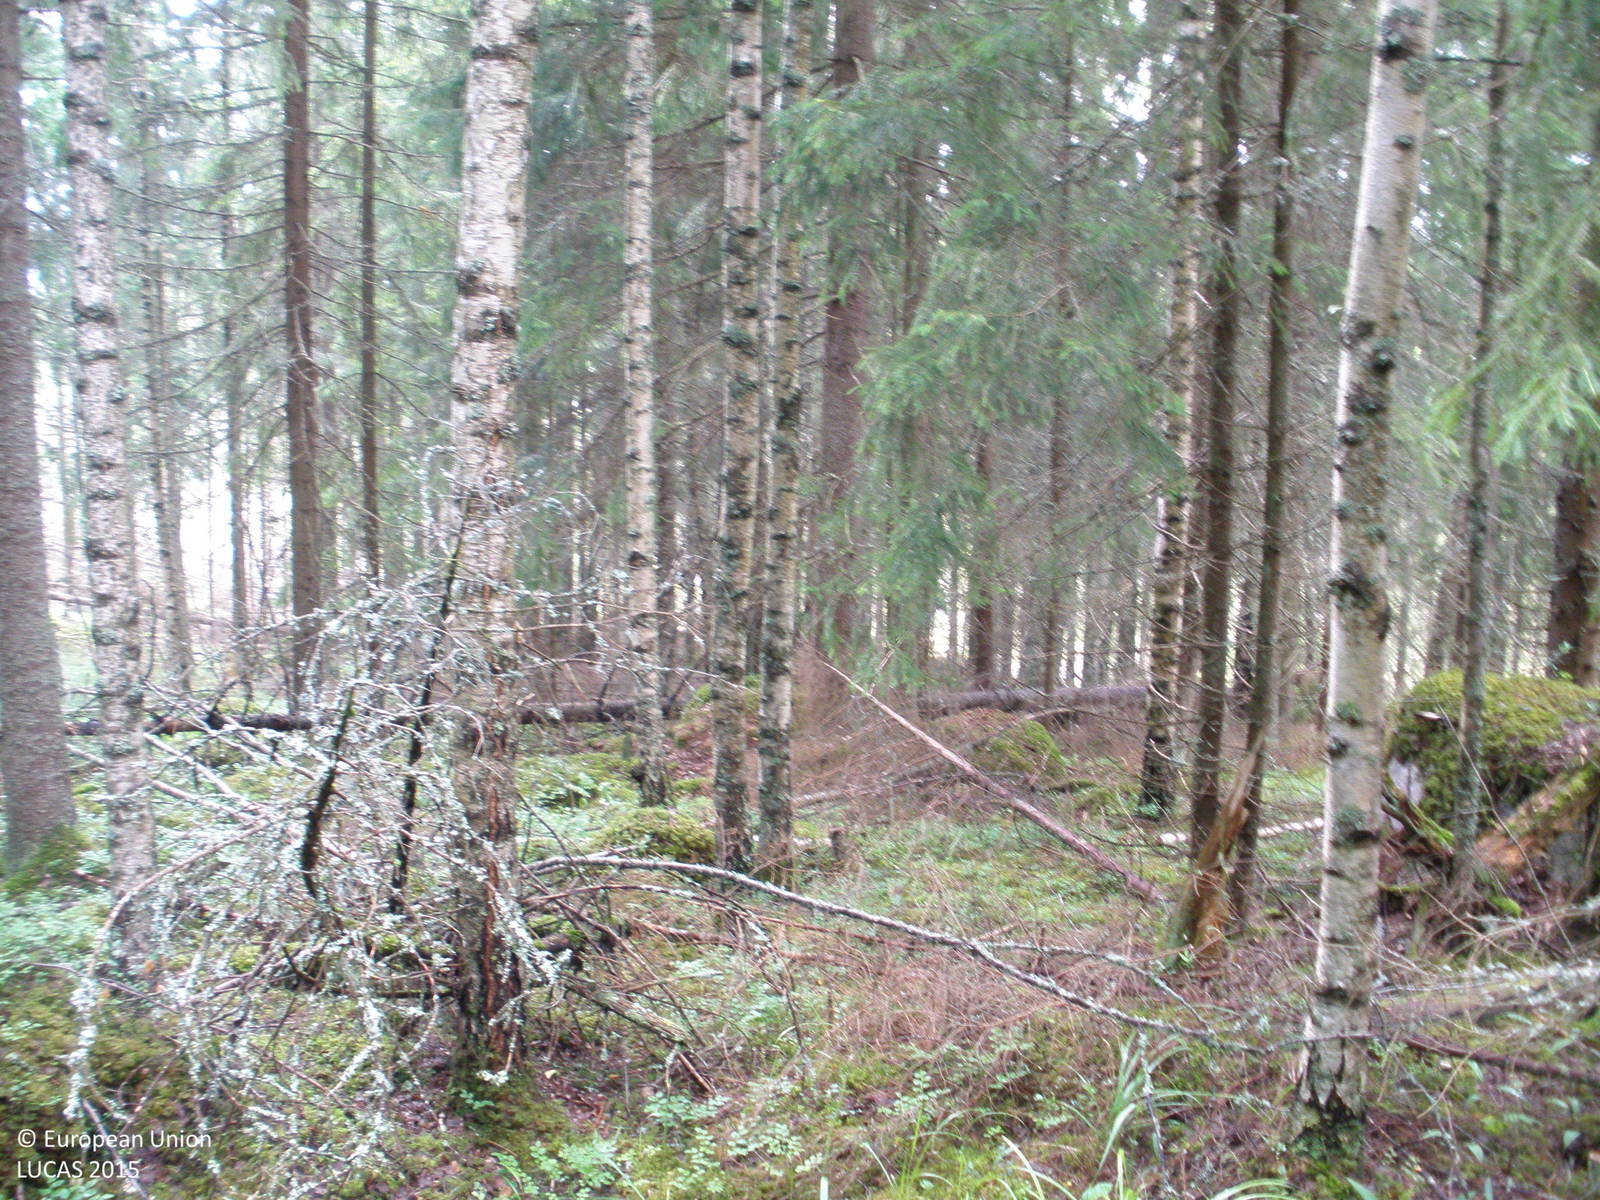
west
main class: Woodland
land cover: Spruce dominated mixed woodland
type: boreal forest
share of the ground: > 75 %
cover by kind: coniferous forest trees 60 %, broadleaved forest trees 30 %, herbaceous plants 5 %, lichens and mosses 5 %
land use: Forestry
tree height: > 5 m
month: July
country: FI
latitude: 61.4257
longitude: 23.1751
